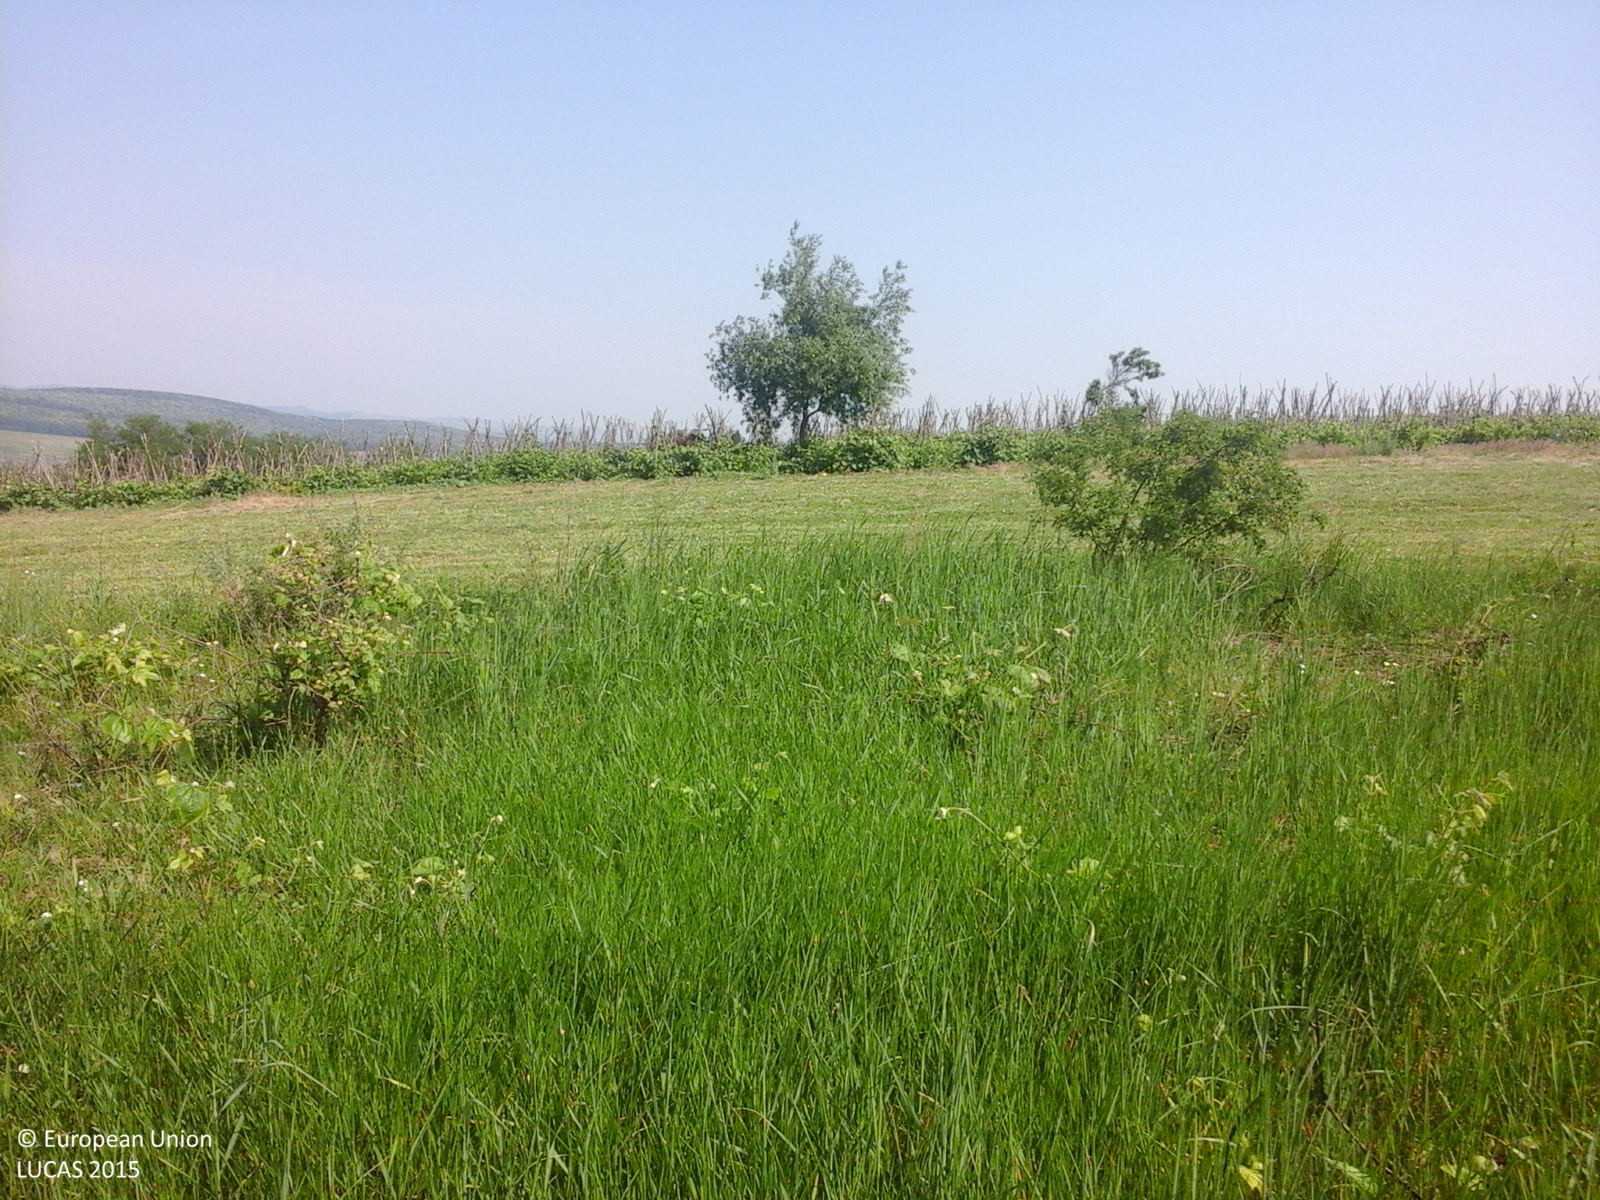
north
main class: Cropland
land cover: Vineyards
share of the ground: 10 - 25 %
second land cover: Grassland without tree/shrub cover
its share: 50 - 75 %
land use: Agriculture (excluding fallow land and kitchen gardens)
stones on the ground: < 10 %
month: June
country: RO
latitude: 46.3399
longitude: 27.1045
